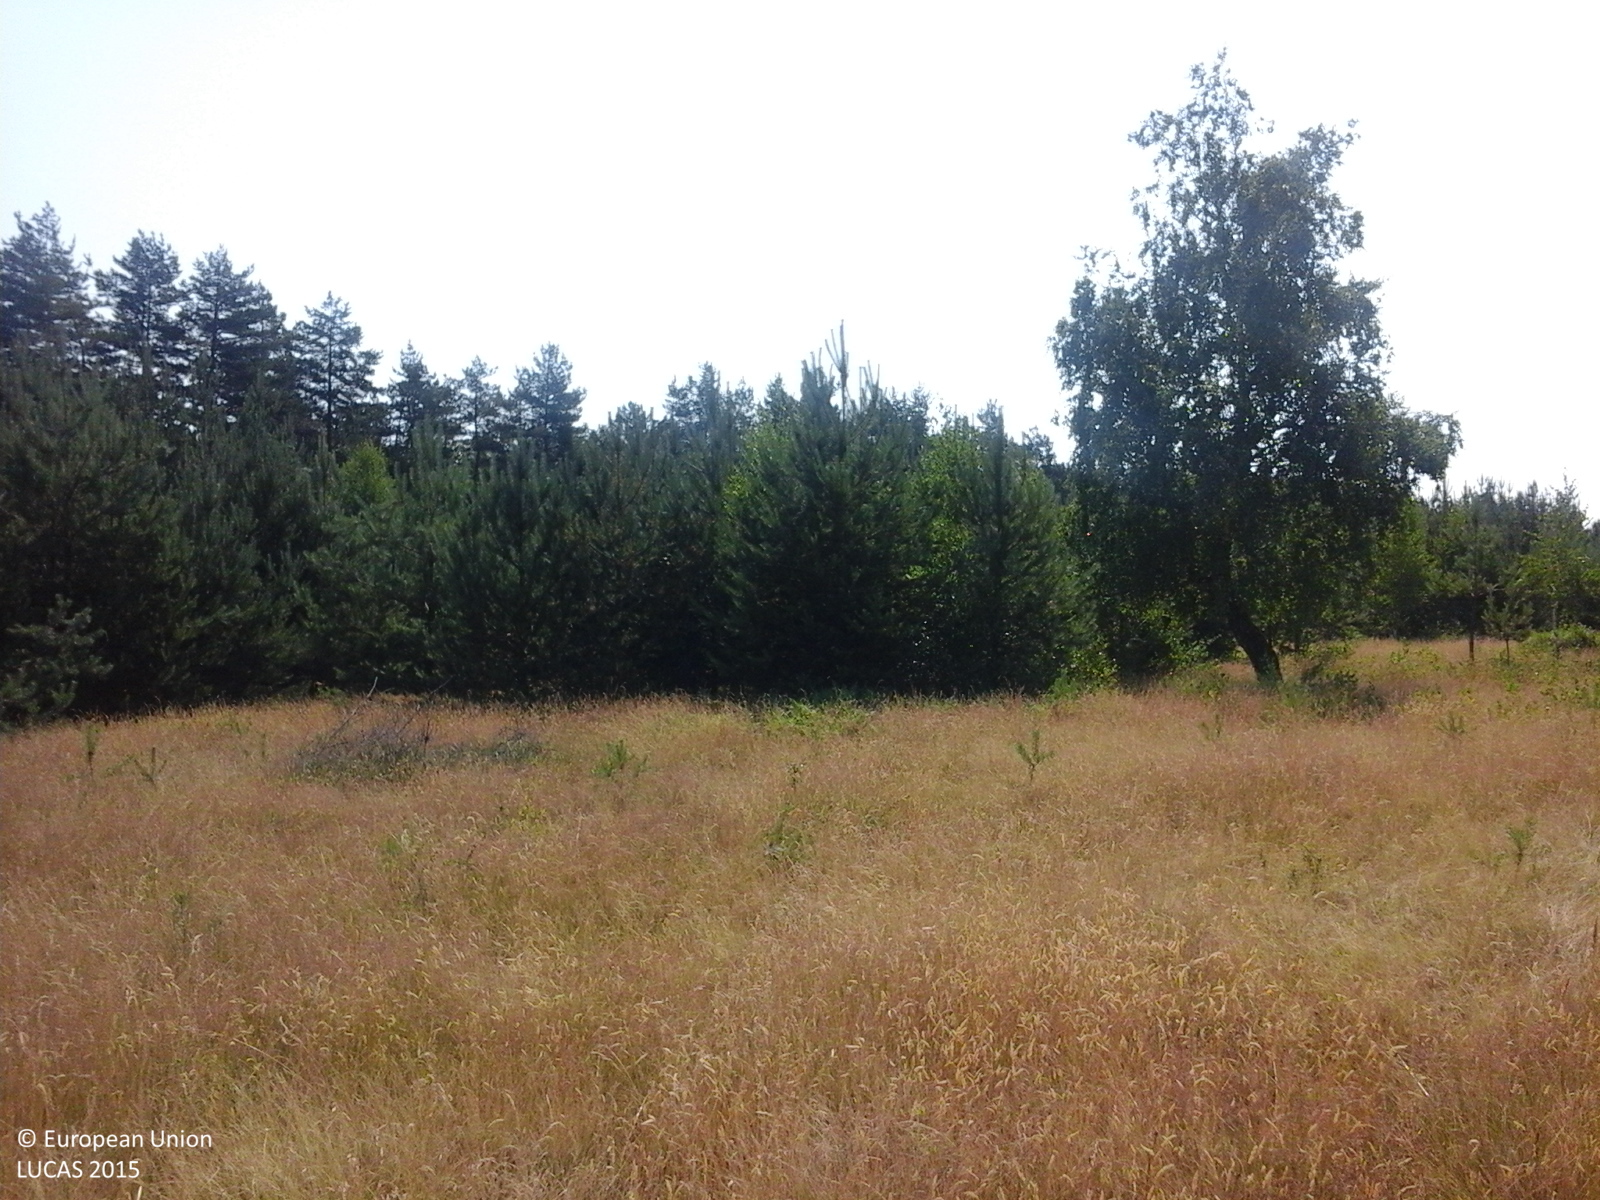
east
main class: Grassland
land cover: Grassland with sparse tree/shrub cover
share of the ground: > 75 %
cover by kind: herbaceous plants 85 %, shrubs 10 %, broadleaved forest trees 5 %
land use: Agriculture (excluding fallow land and kitchen gardens)
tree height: < 5 m
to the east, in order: Grassland with sparse tree/shrub cover; Spruce dominated coniferous woodland; Spruce dominated mixed woodland; Grassland with sparse tree/shrub cover; Grassland without tree/shrub cover
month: July
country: RO
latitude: 45.0302
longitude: 24.6108
